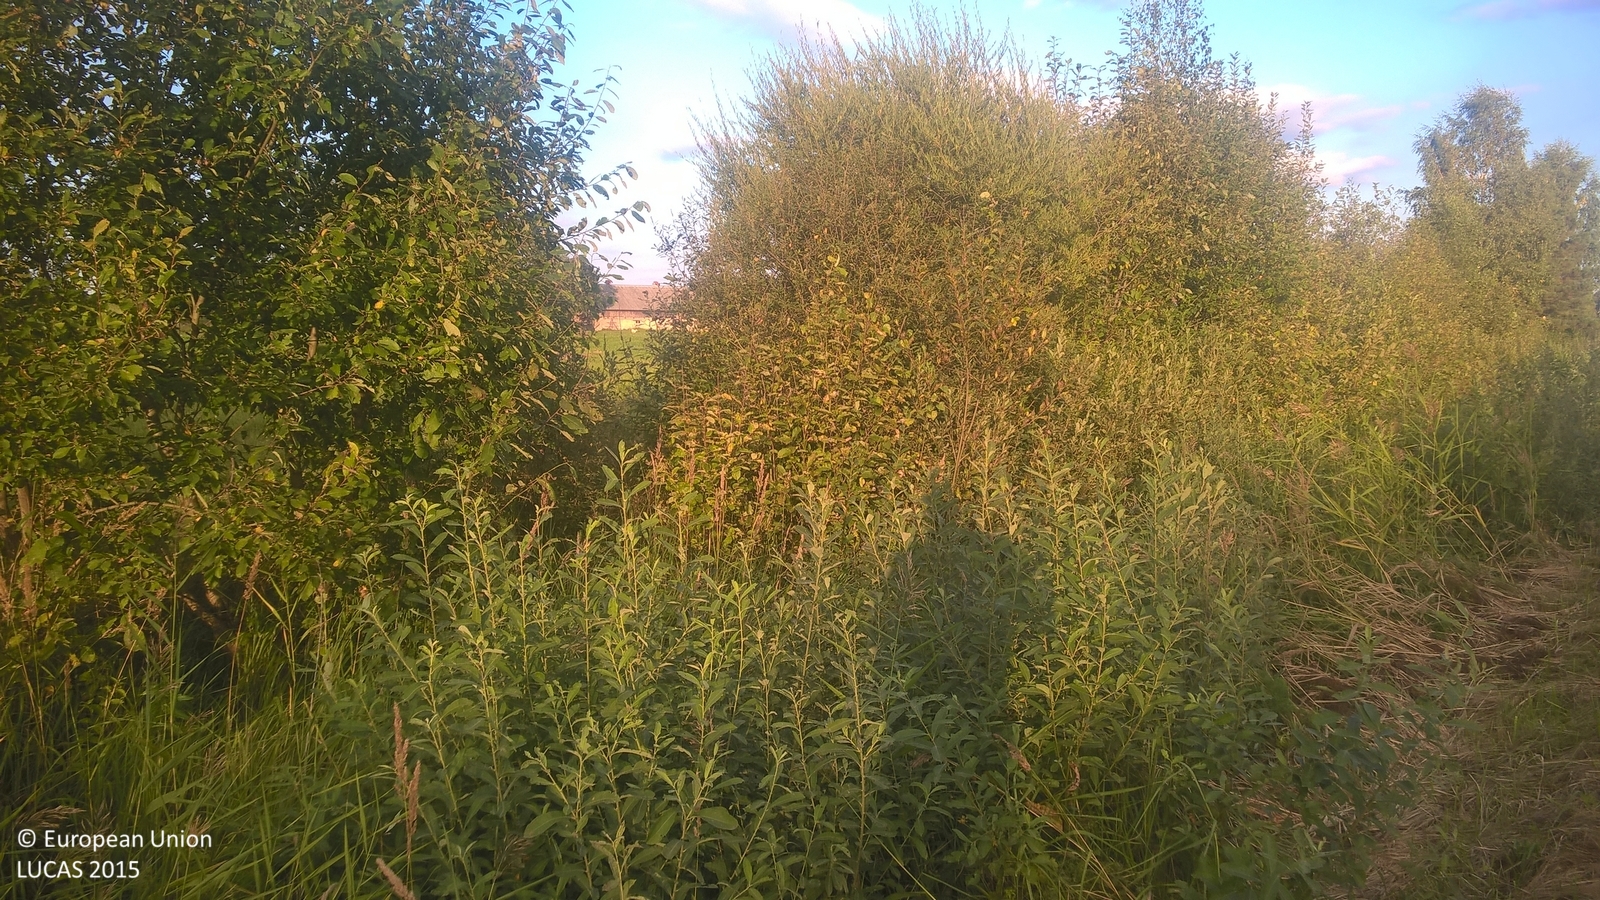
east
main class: Grassland
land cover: Grassland without tree/shrub cover
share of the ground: > 75 %
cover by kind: herbaceous plants 100 %
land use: Agriculture (excluding fallow land and kitchen gardens)
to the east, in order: Grassland without tree/shrub cover; Artificial constructions in urban areas
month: September
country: LV
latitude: 57.4822
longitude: 25.6129
